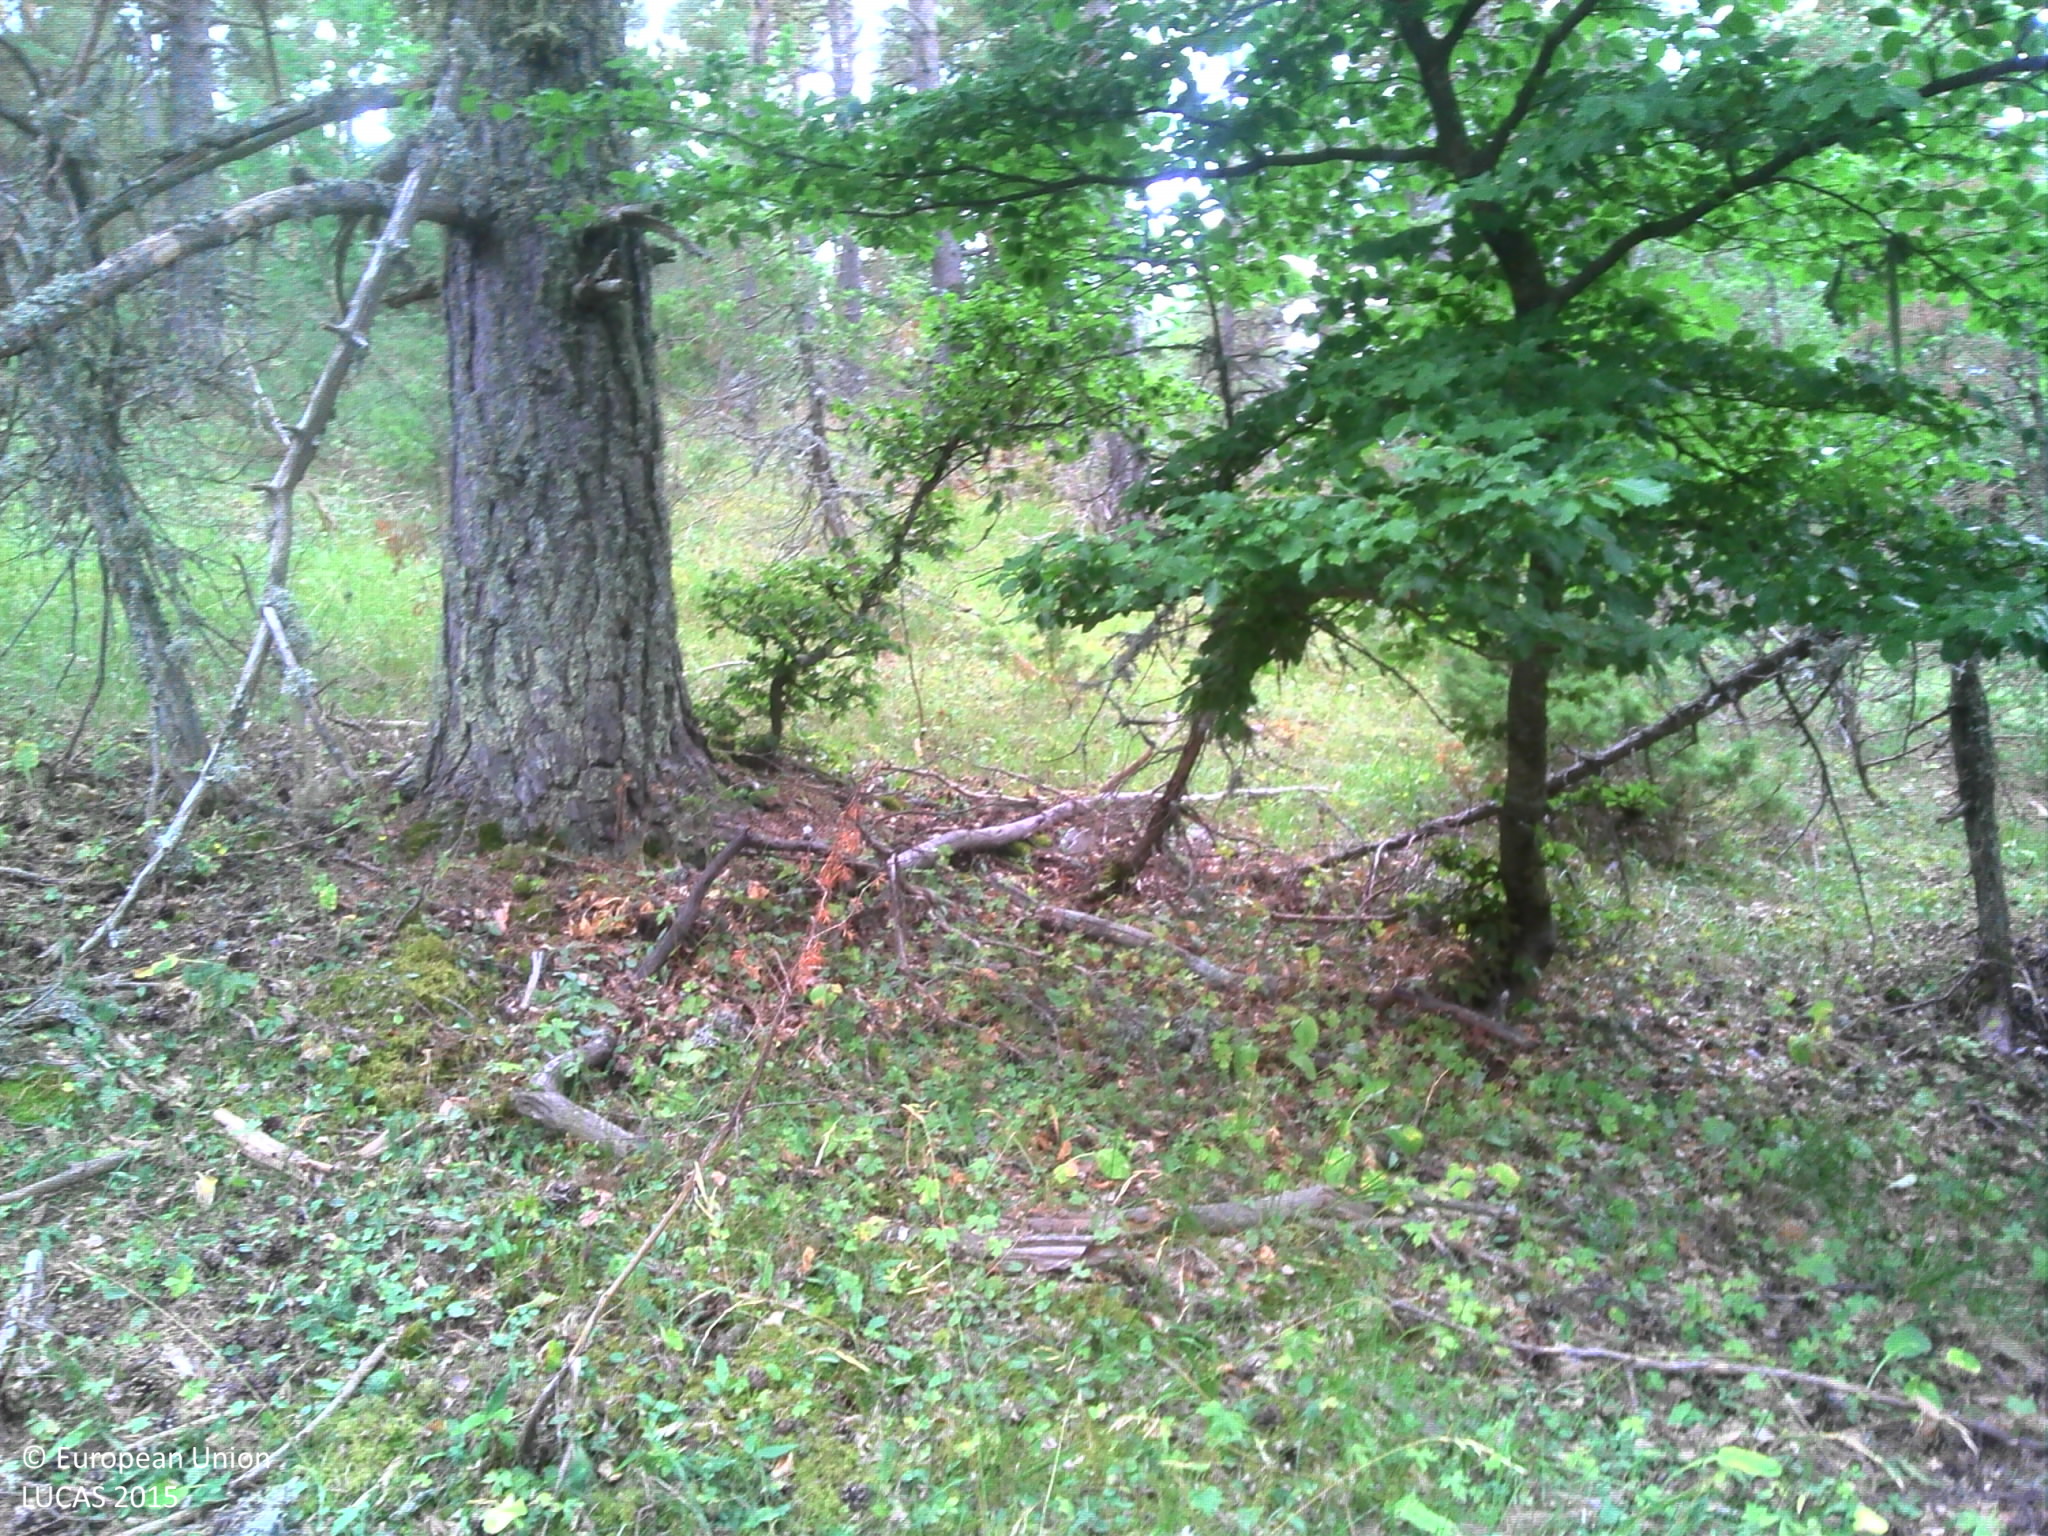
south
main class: Woodland
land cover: Pine dominated coniferous woodland
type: alpine coniferous forest
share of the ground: 50 - 75 %
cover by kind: coniferous forest trees 60 %, herbaceous plants 20 %, broadleaved forest trees 10 %, lichens and mosses 10 %
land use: Forestry
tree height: > 5 m
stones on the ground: 10 - 25 %
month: August
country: FR
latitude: 44.0602
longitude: 6.5992
